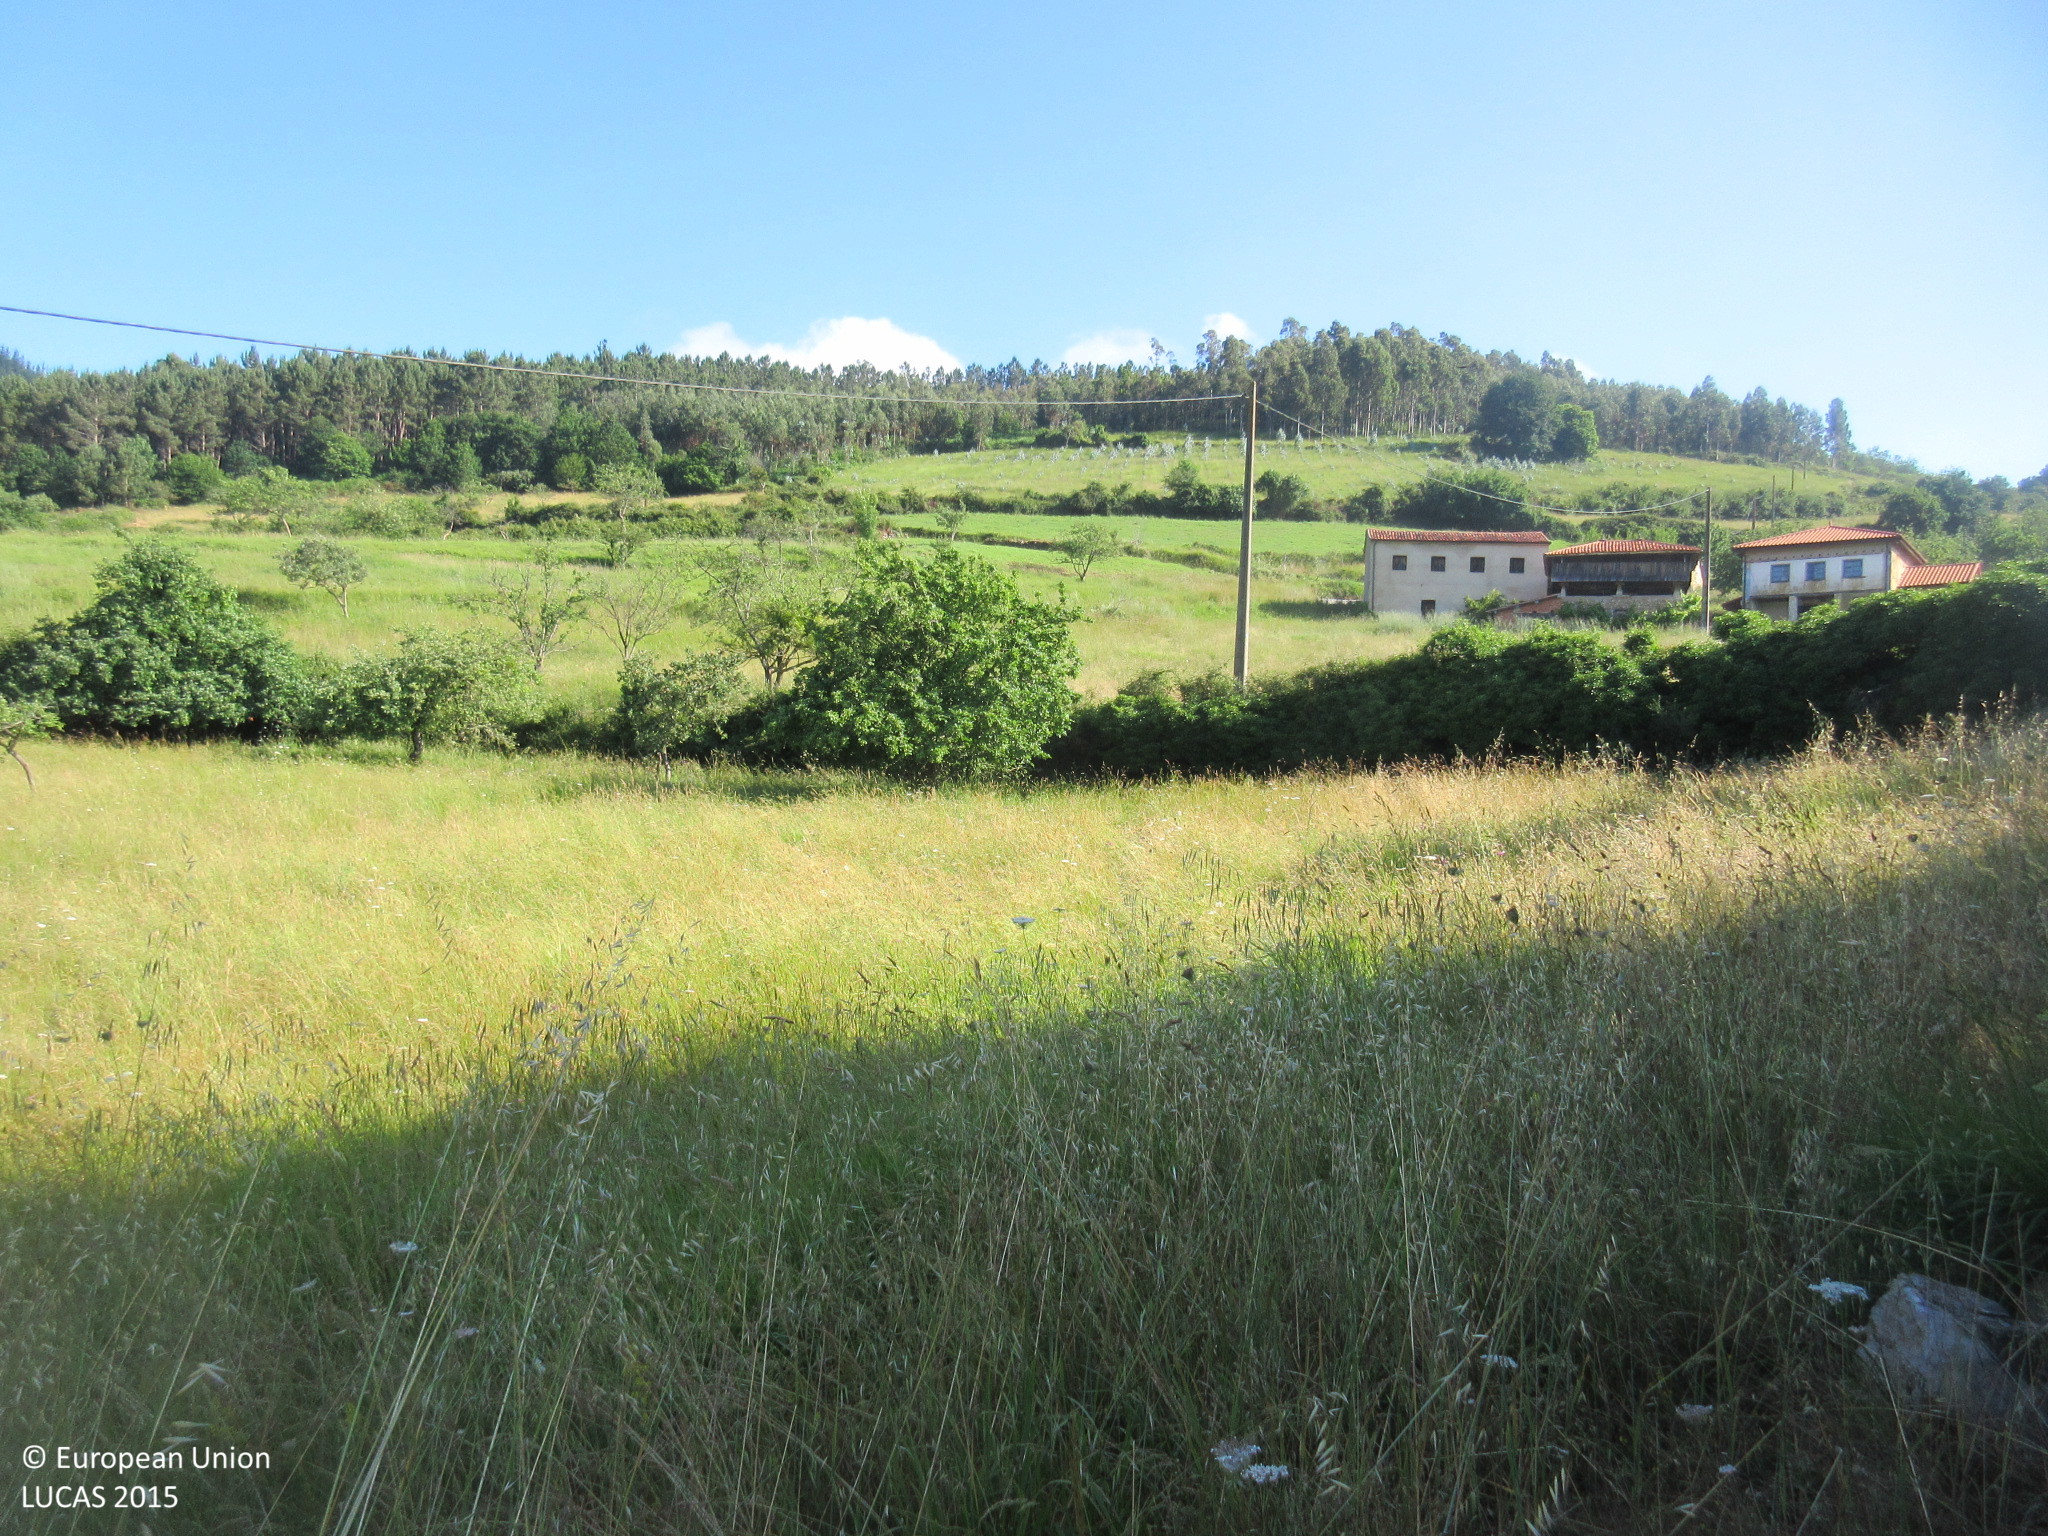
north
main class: Woodland
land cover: Broadleaved woodland
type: broadleaved evergreen forest
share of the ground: > 75 %
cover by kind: broadleaved forest trees 90 %, shrubs 10 %
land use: Semi-natural and natural areas not in use
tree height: > 5 m
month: June
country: ES
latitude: 43.4099
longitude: -6.0099
